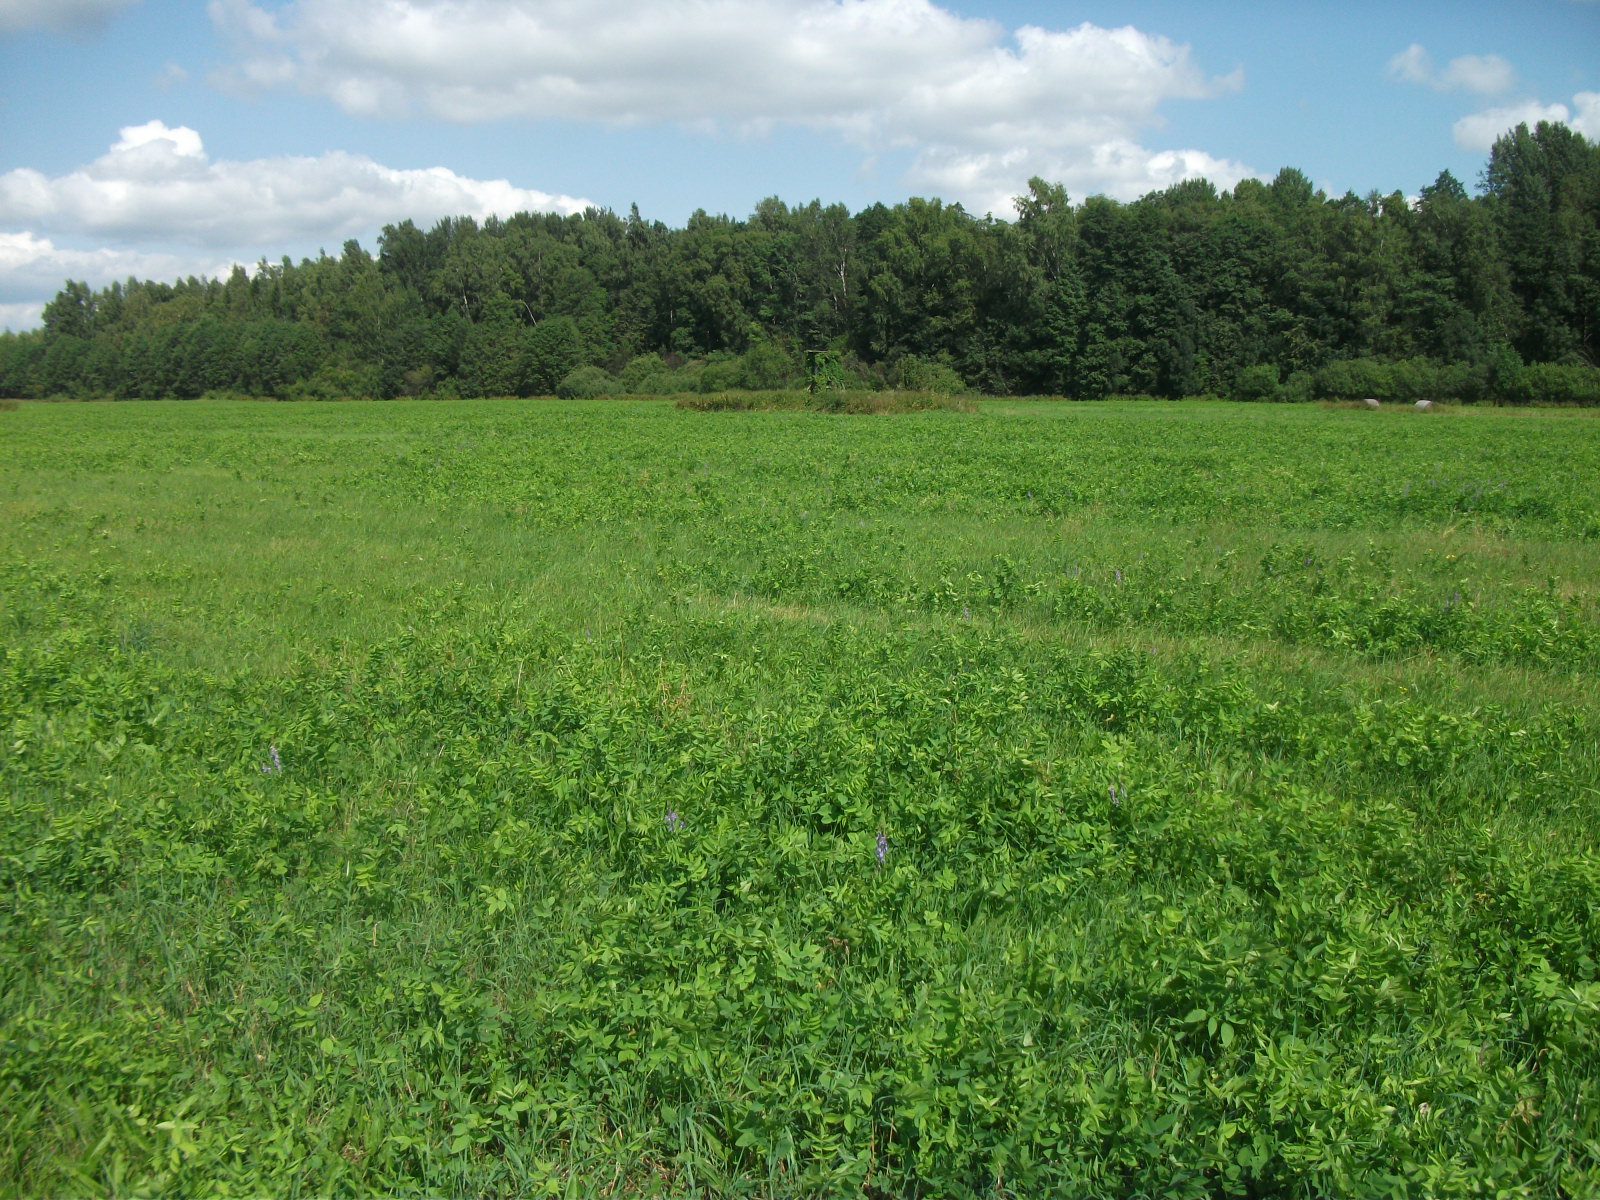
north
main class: Grassland
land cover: Grassland without tree/shrub cover
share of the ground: > 75 %
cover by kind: herbaceous plants 100 %
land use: Agriculture (excluding fallow land and kitchen gardens)
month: August
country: LV
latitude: 56.8912
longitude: 26.3765
